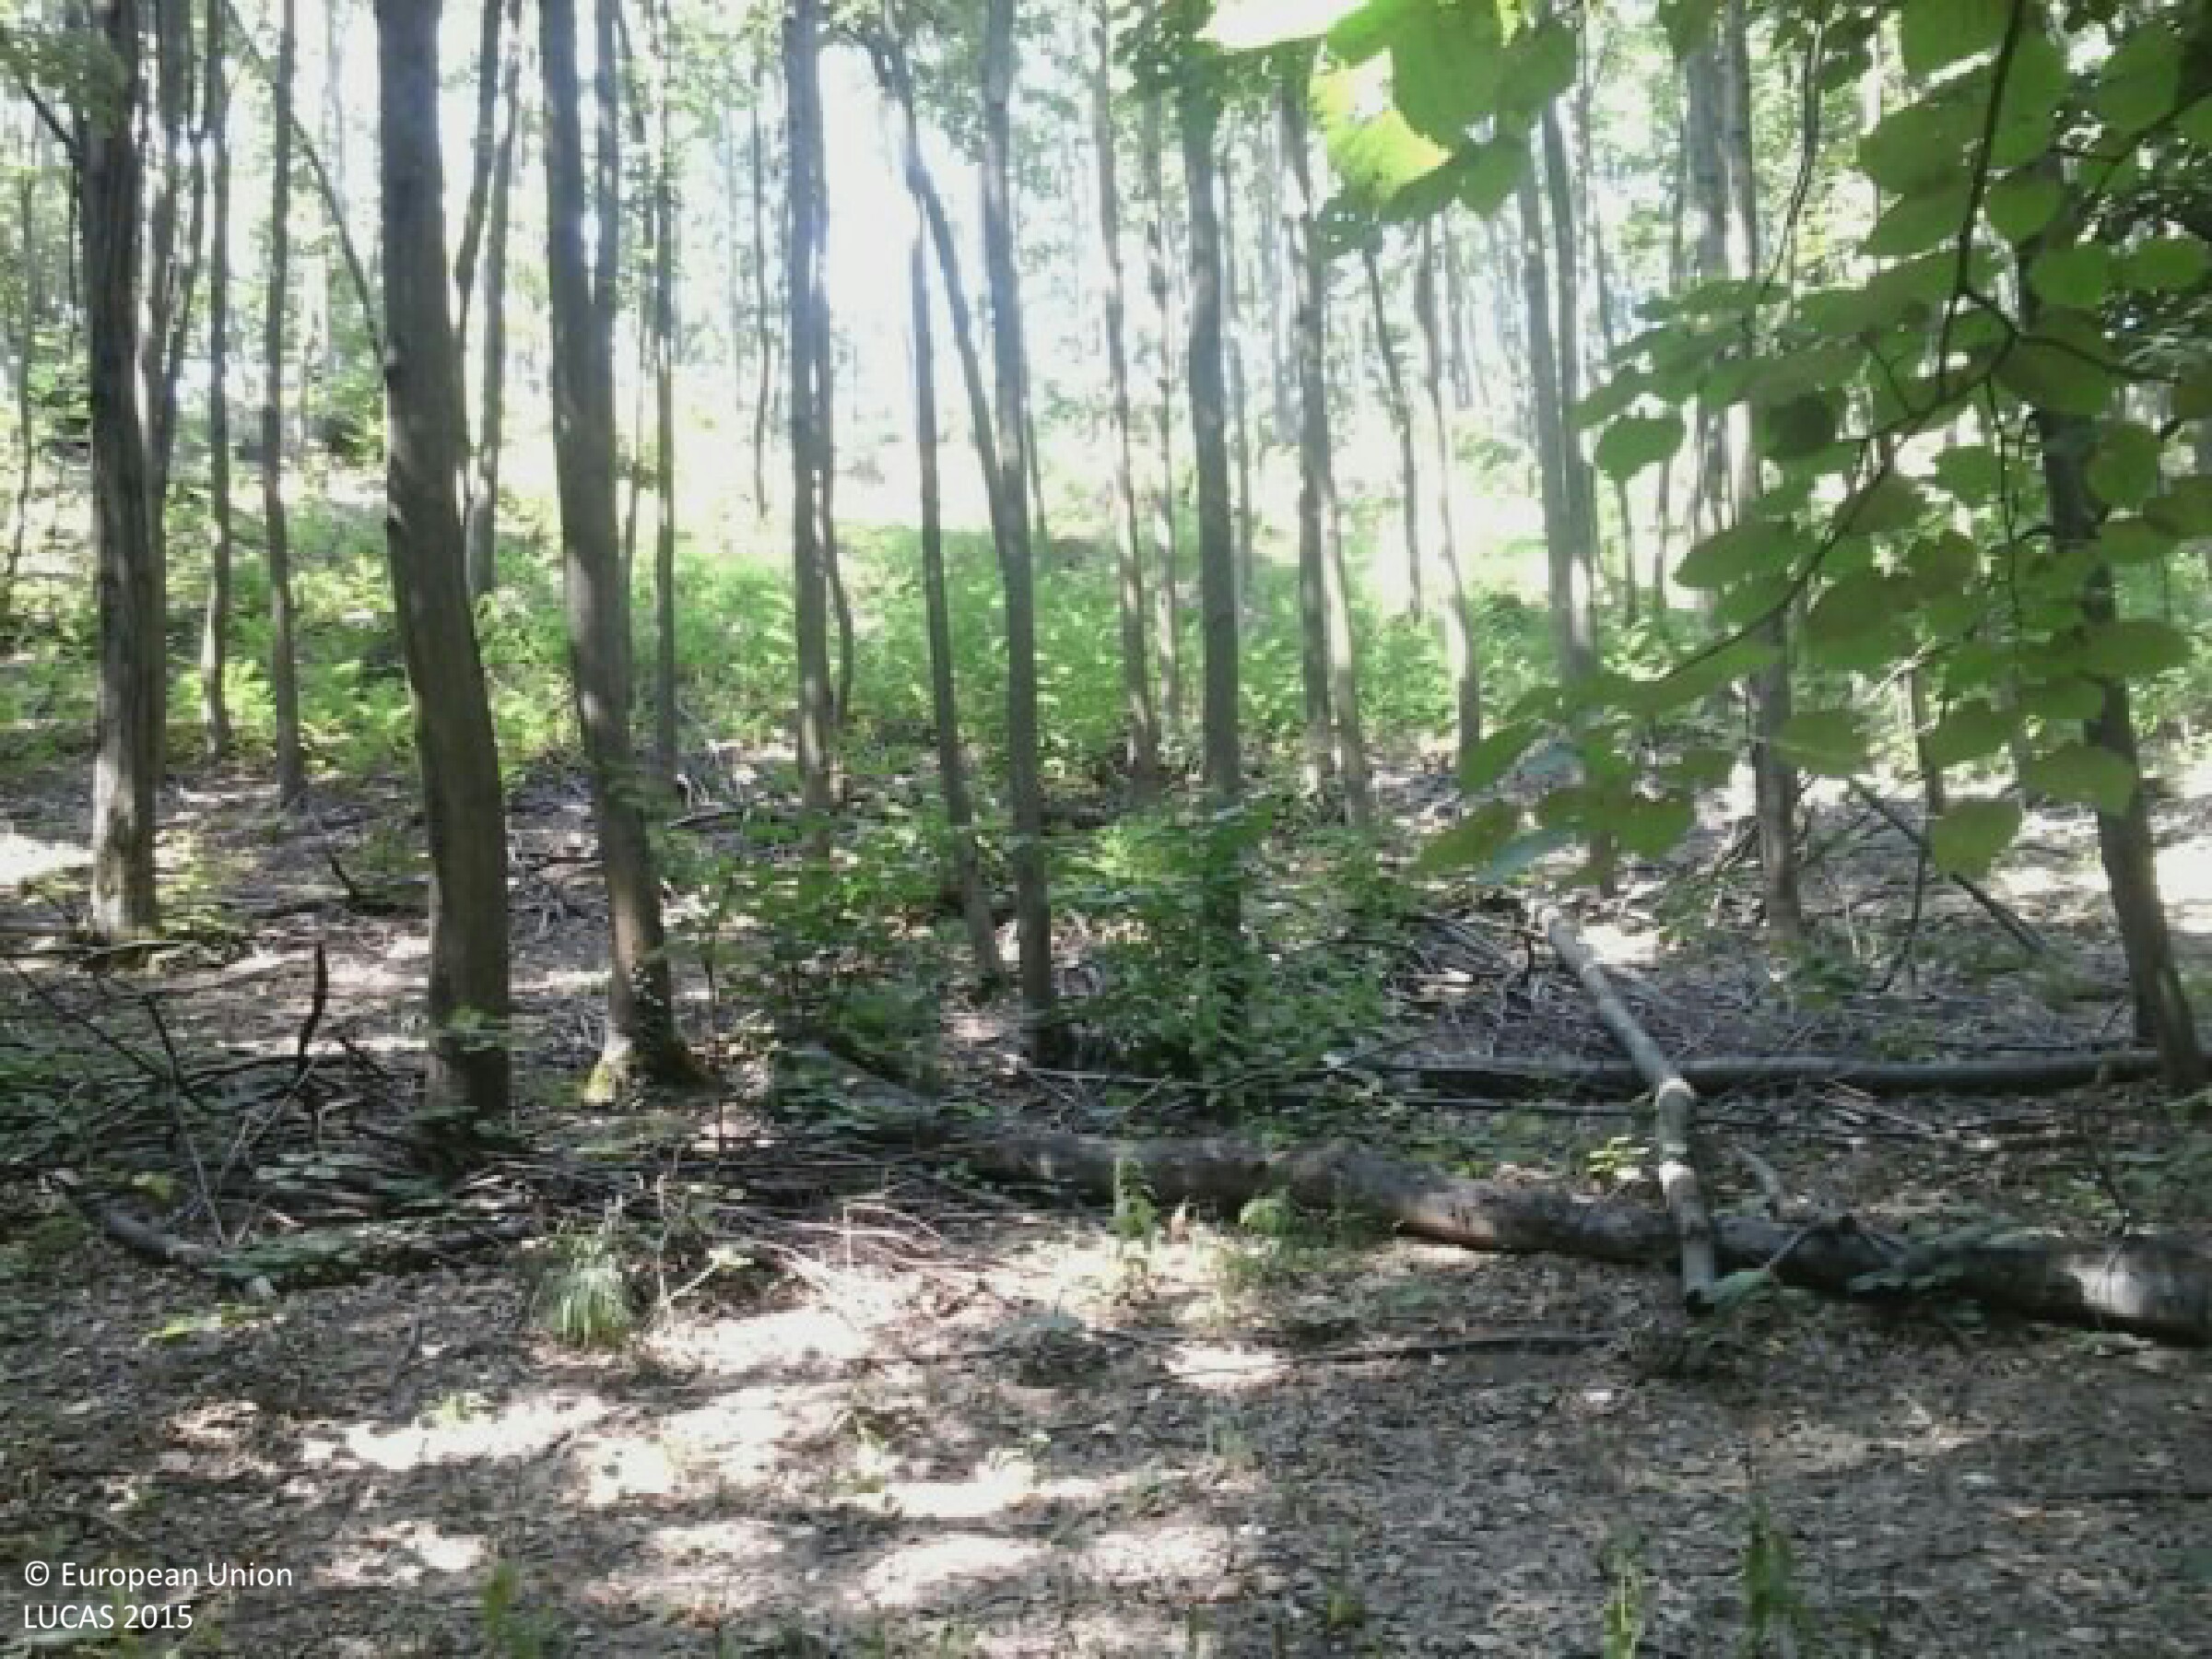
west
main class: Woodland
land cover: Broadleaved woodland
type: mesophytic deciduous forest
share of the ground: > 75 %
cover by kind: broadleaved forest trees 70 %, shrubs 20 %, consolidated bare surface 10 %
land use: Forestry
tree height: > 5 m
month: August
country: HU
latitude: 46.2470
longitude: 17.8006
